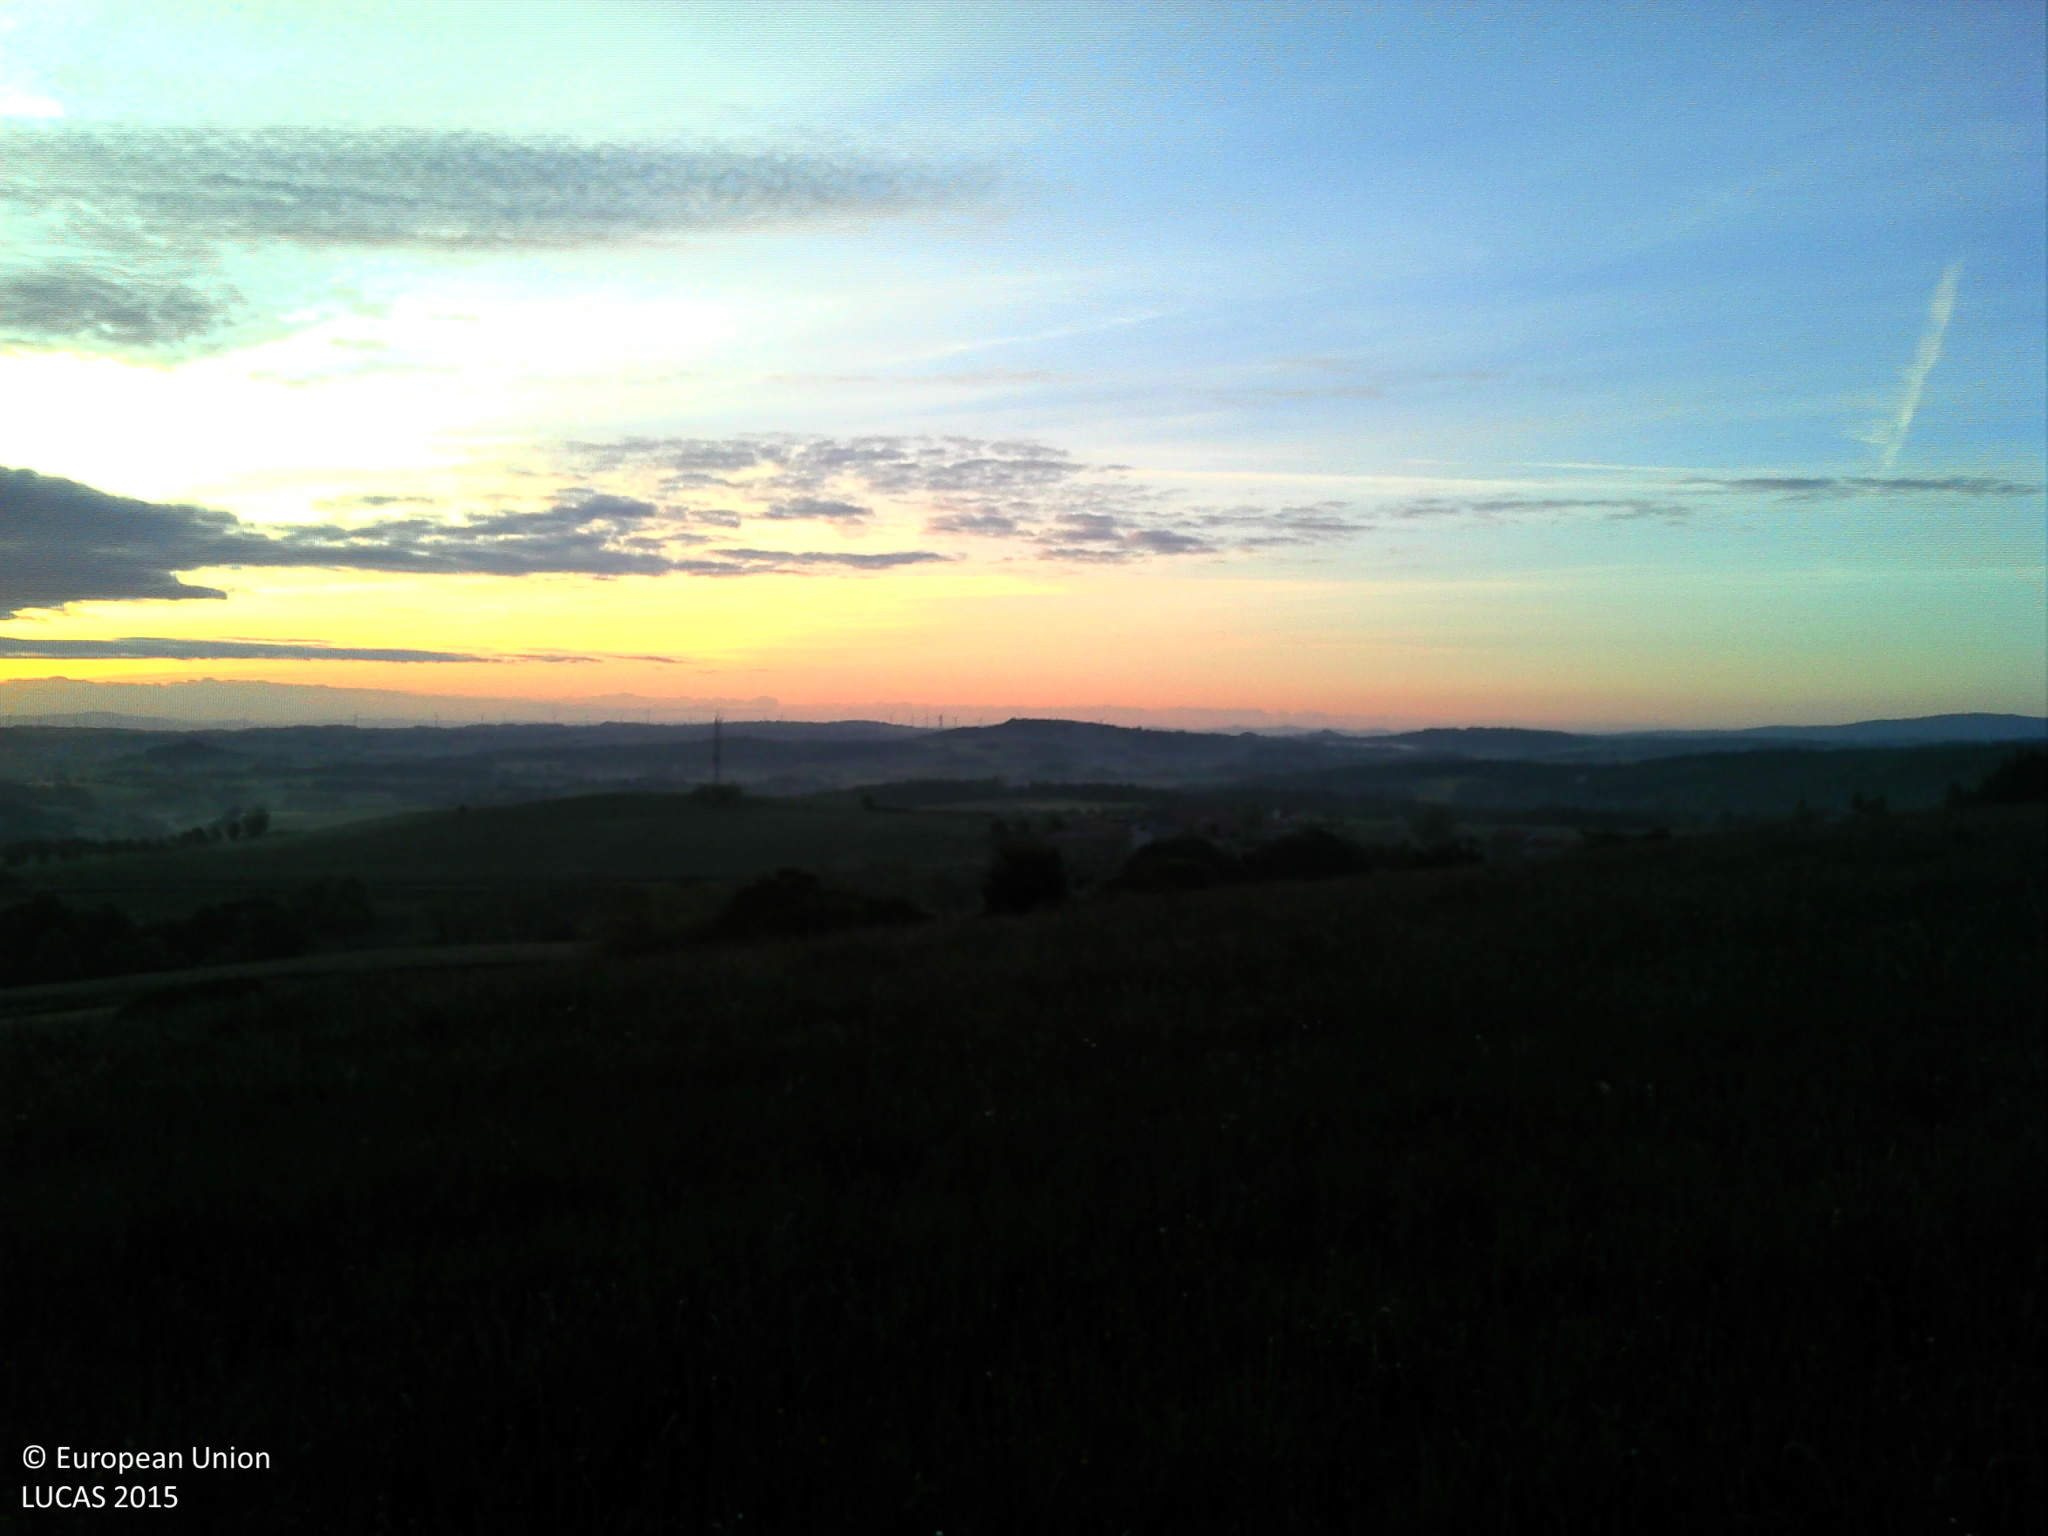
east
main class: Grassland
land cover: Grassland without tree/shrub cover
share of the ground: > 75 %
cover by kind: herbaceous plants 100 %
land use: Agriculture (excluding fallow land and kitchen gardens)
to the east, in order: Grassland without tree/shrub cover; Grassland with sparse tree/shrub cover; Grassland without tree/shrub cover; Other bare soil; Fences; Grass margins; Paved roads, cycling and walking lanes; Grass margins; Fences; Lines of trees; Grassland without tree/shrub cover
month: May
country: FR
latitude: 45.1174
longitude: 3.1250
